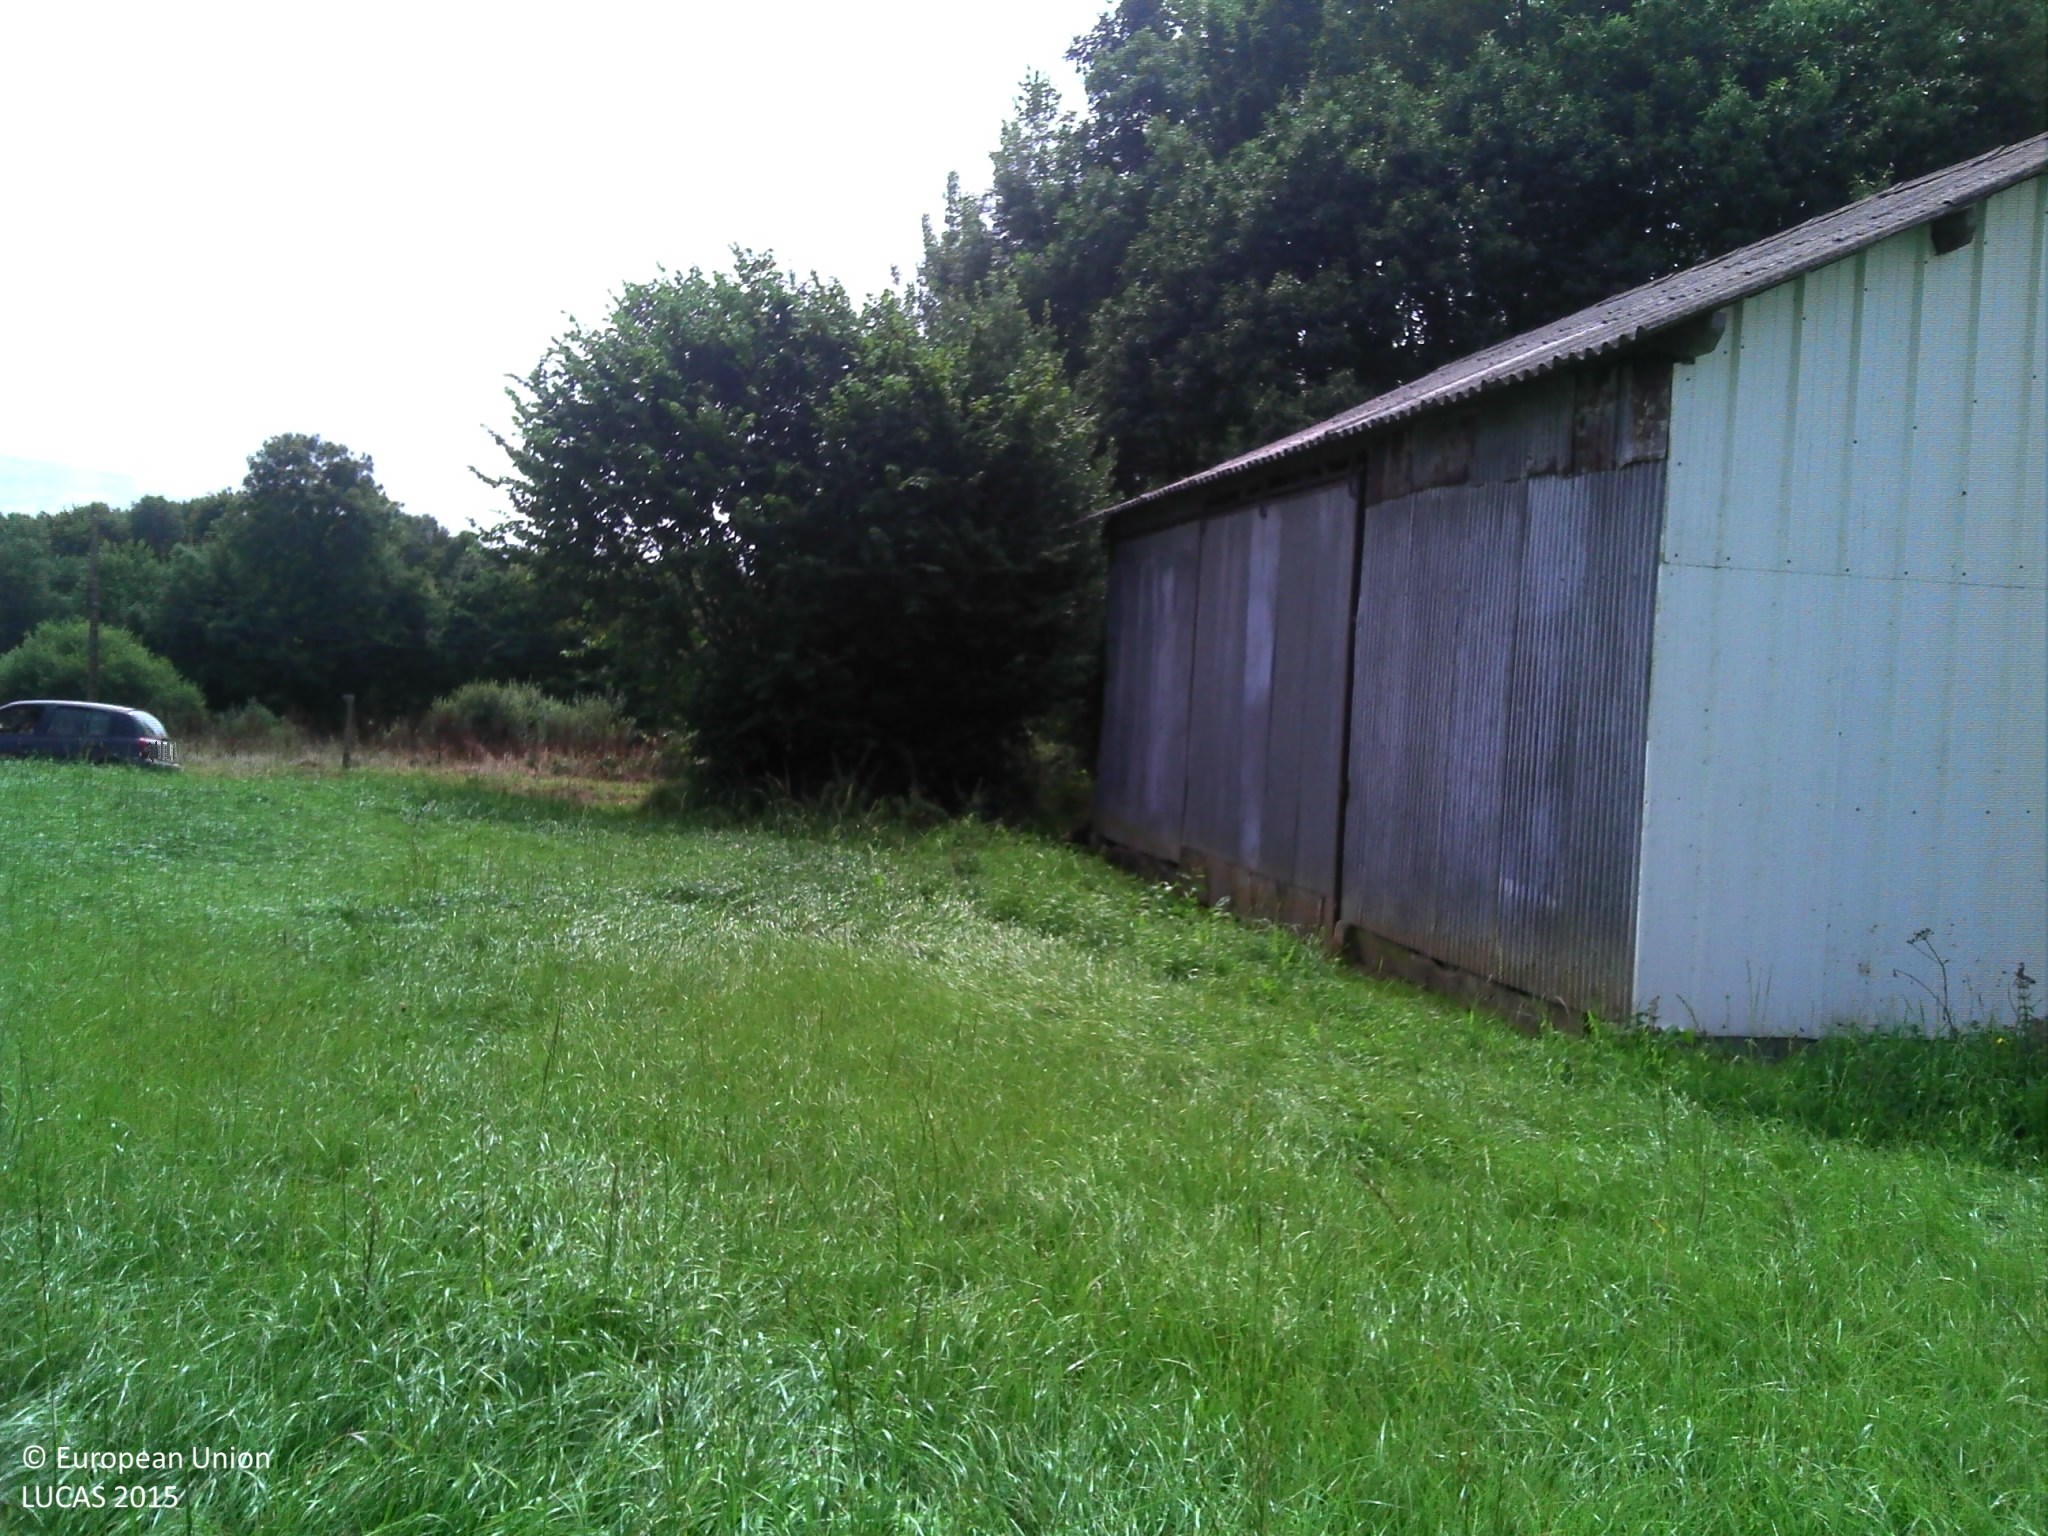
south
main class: Cropland
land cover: Temporary grasslands
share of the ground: > 75 %
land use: Agriculture (excluding fallow land and kitchen gardens)
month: August
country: FR
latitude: 48.5022
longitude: -3.4913
